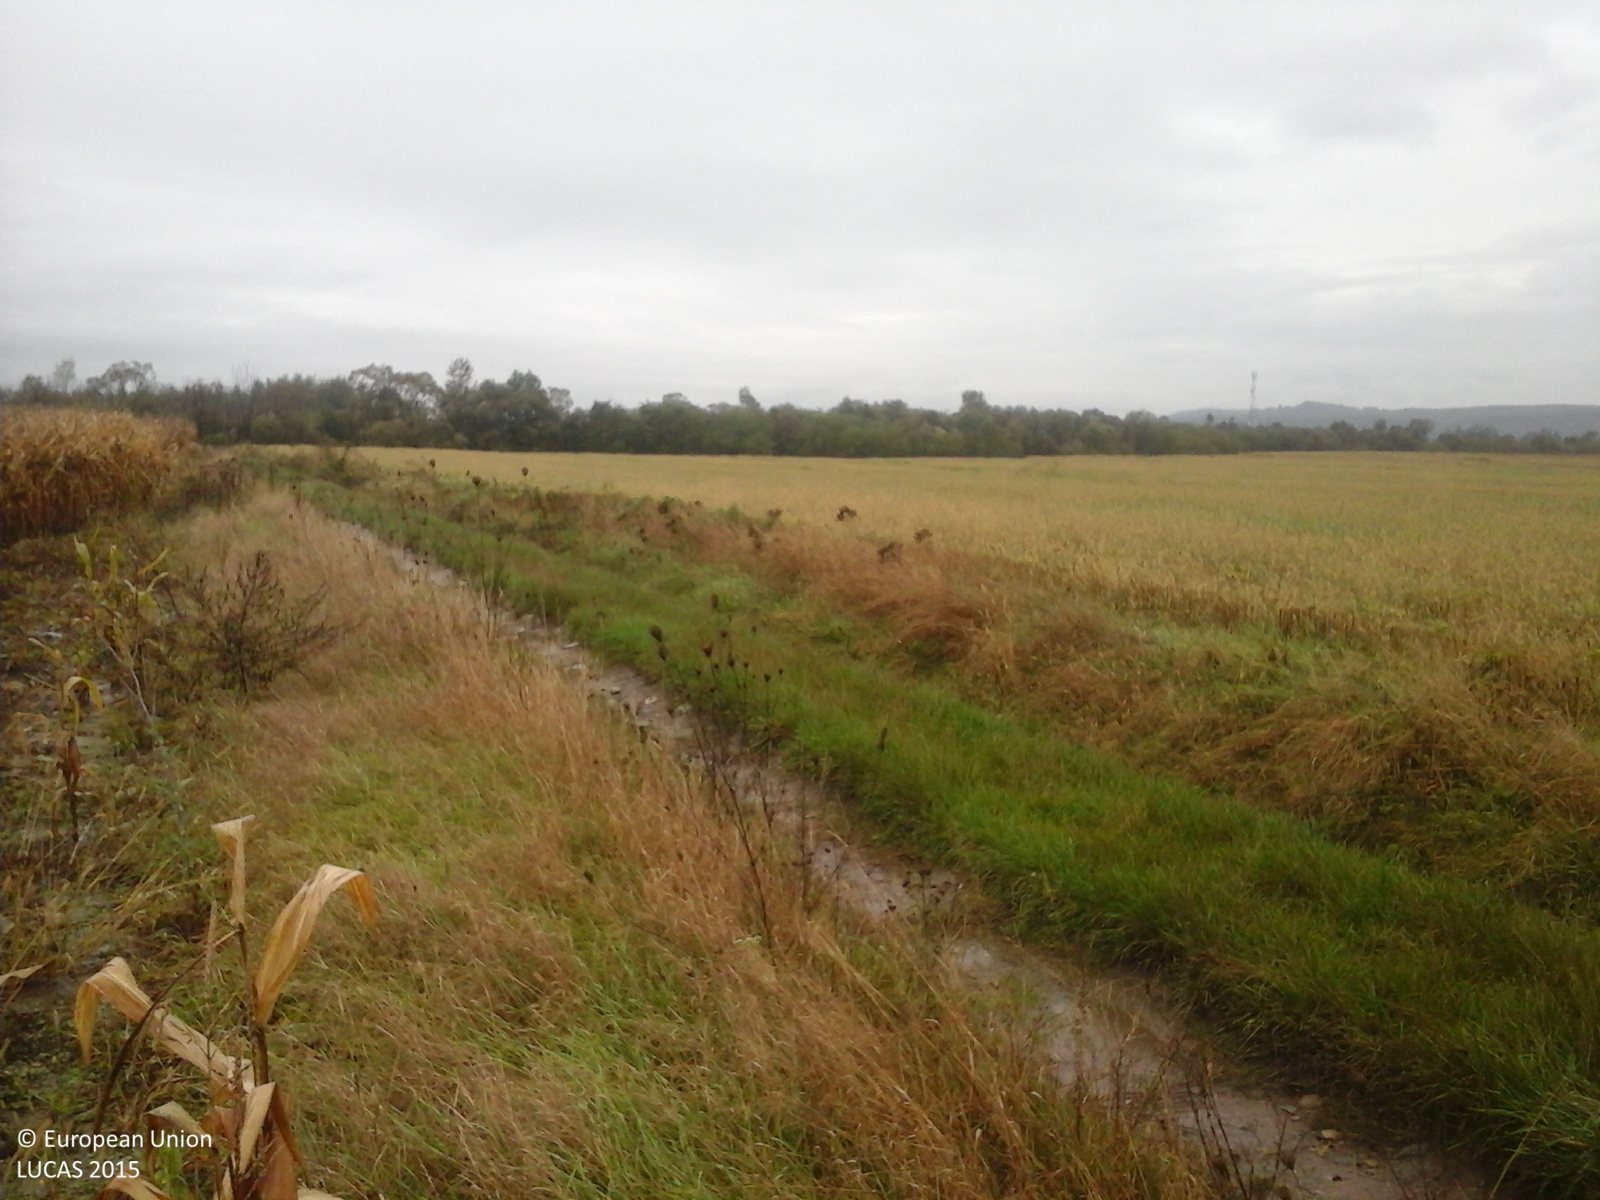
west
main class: Cropland
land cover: Maize
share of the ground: > 75 %
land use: Agriculture (excluding fallow land and kitchen gardens)
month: October
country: RO
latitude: 45.7846
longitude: 24.7107
